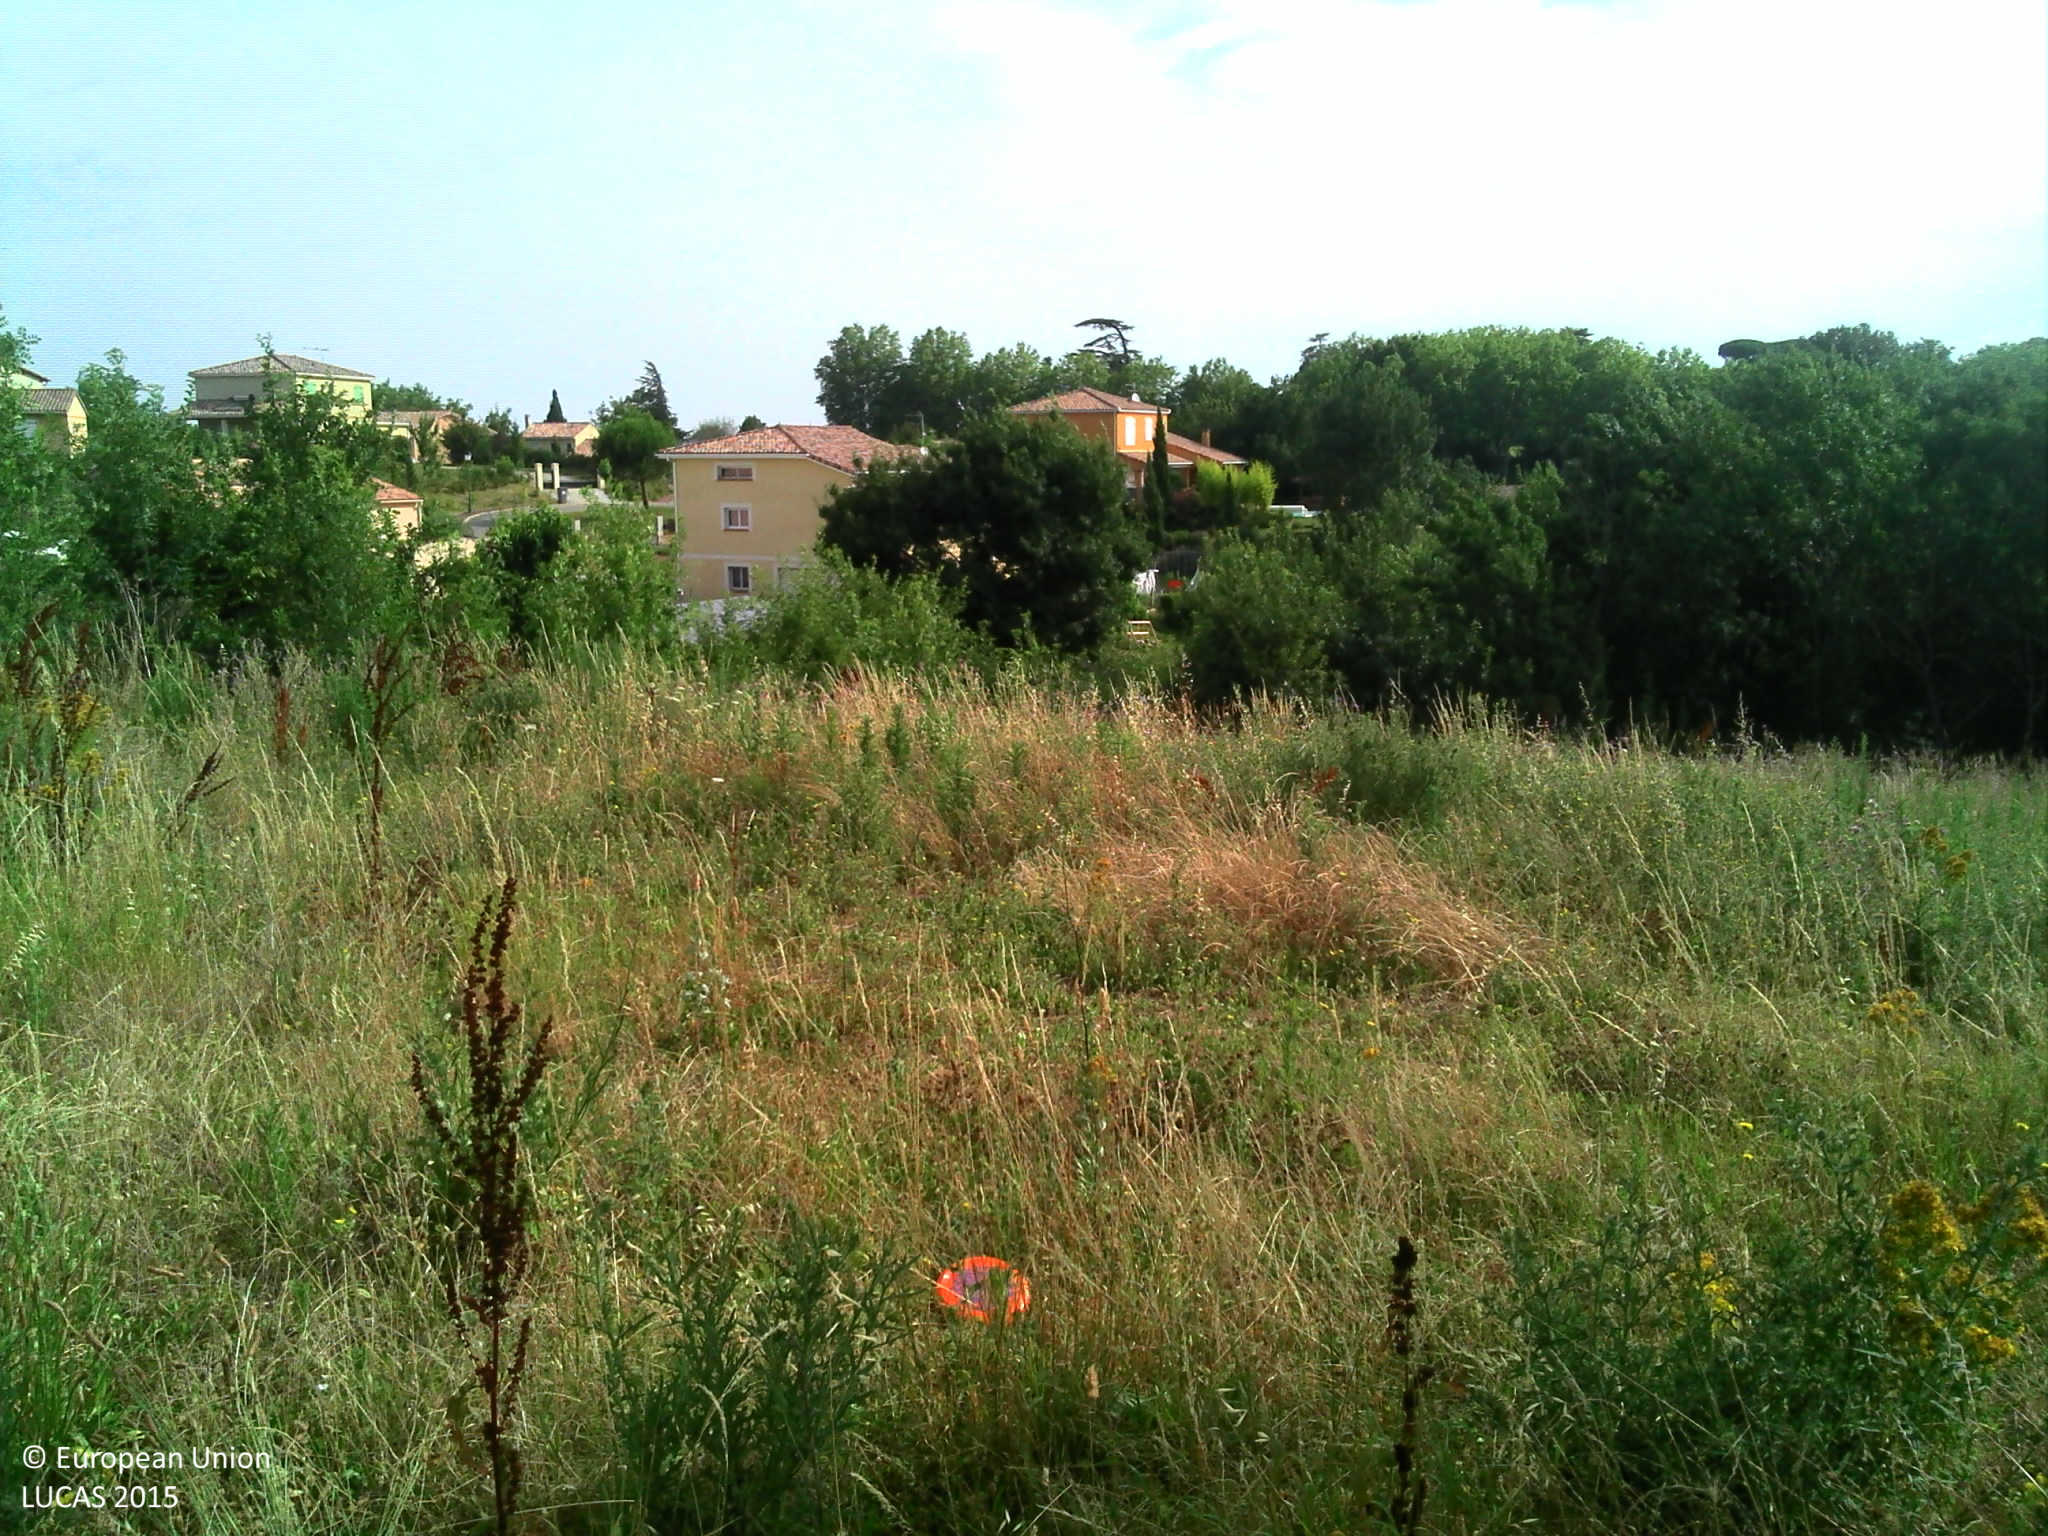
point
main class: Grassland
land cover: Spontaneously vegetated surfaces
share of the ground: > 75 %
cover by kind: herbaceous plants 90 %
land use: Semi-natural and natural areas not in use
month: July
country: FR
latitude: 43.5602
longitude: 1.6474
